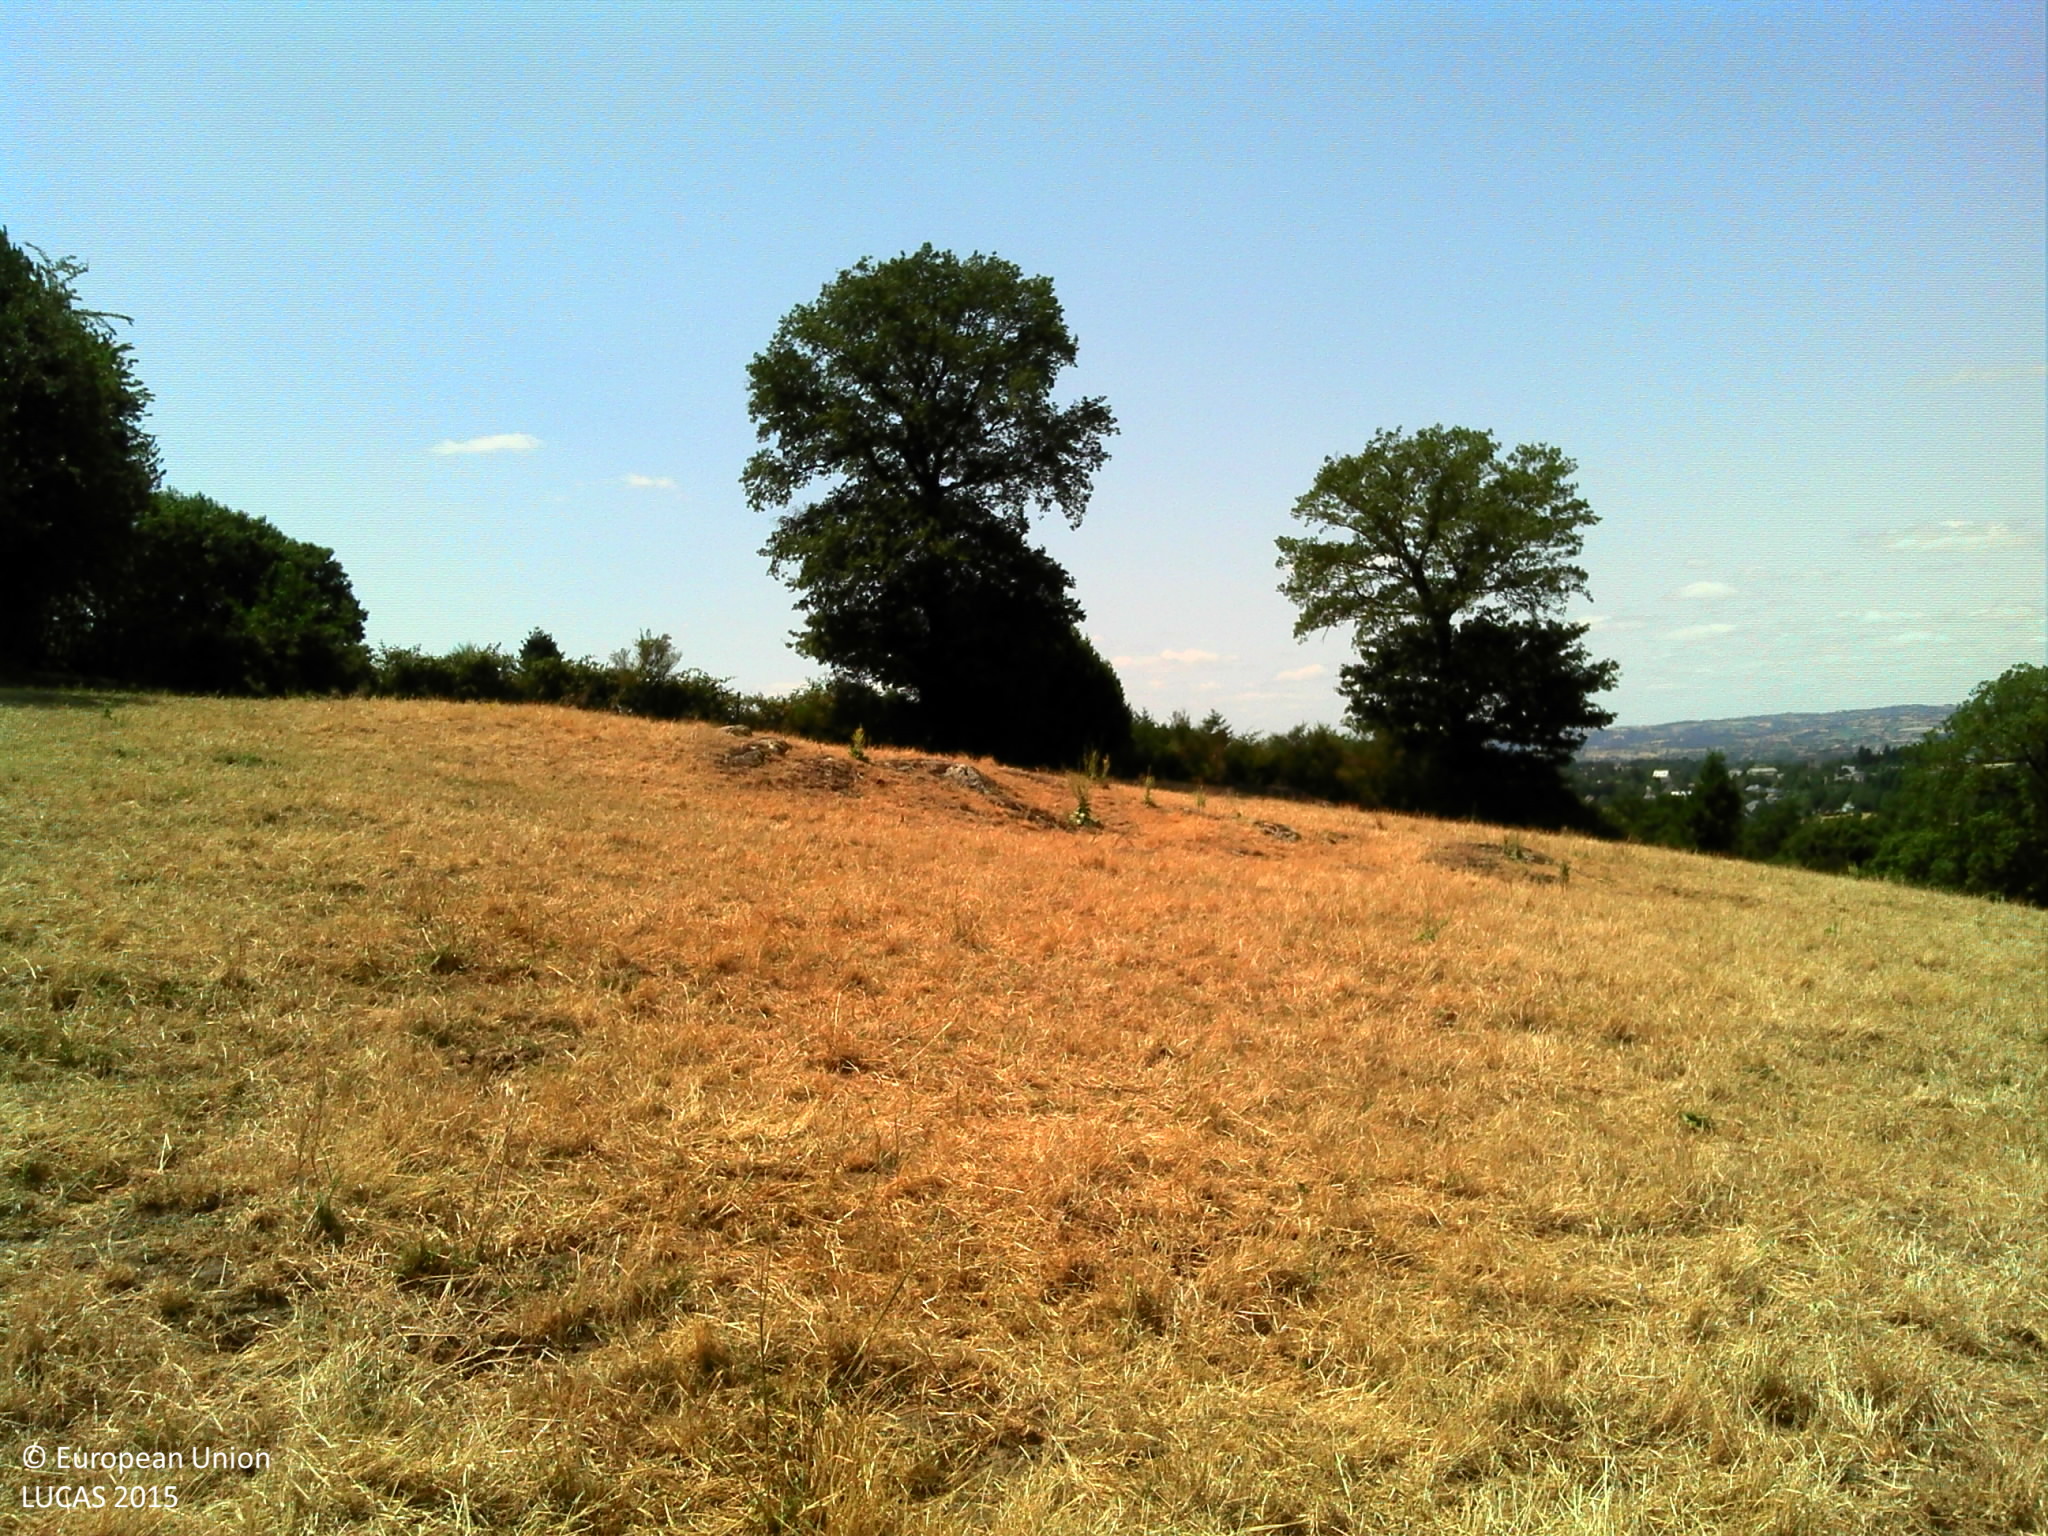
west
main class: Grassland
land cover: Grassland without tree/shrub cover
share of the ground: > 75 %
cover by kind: herbaceous plants 100 %
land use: Agriculture (excluding fallow land and kitchen gardens)
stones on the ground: 10 - 25 %
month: July
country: FR
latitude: 44.1757
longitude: 2.5870
